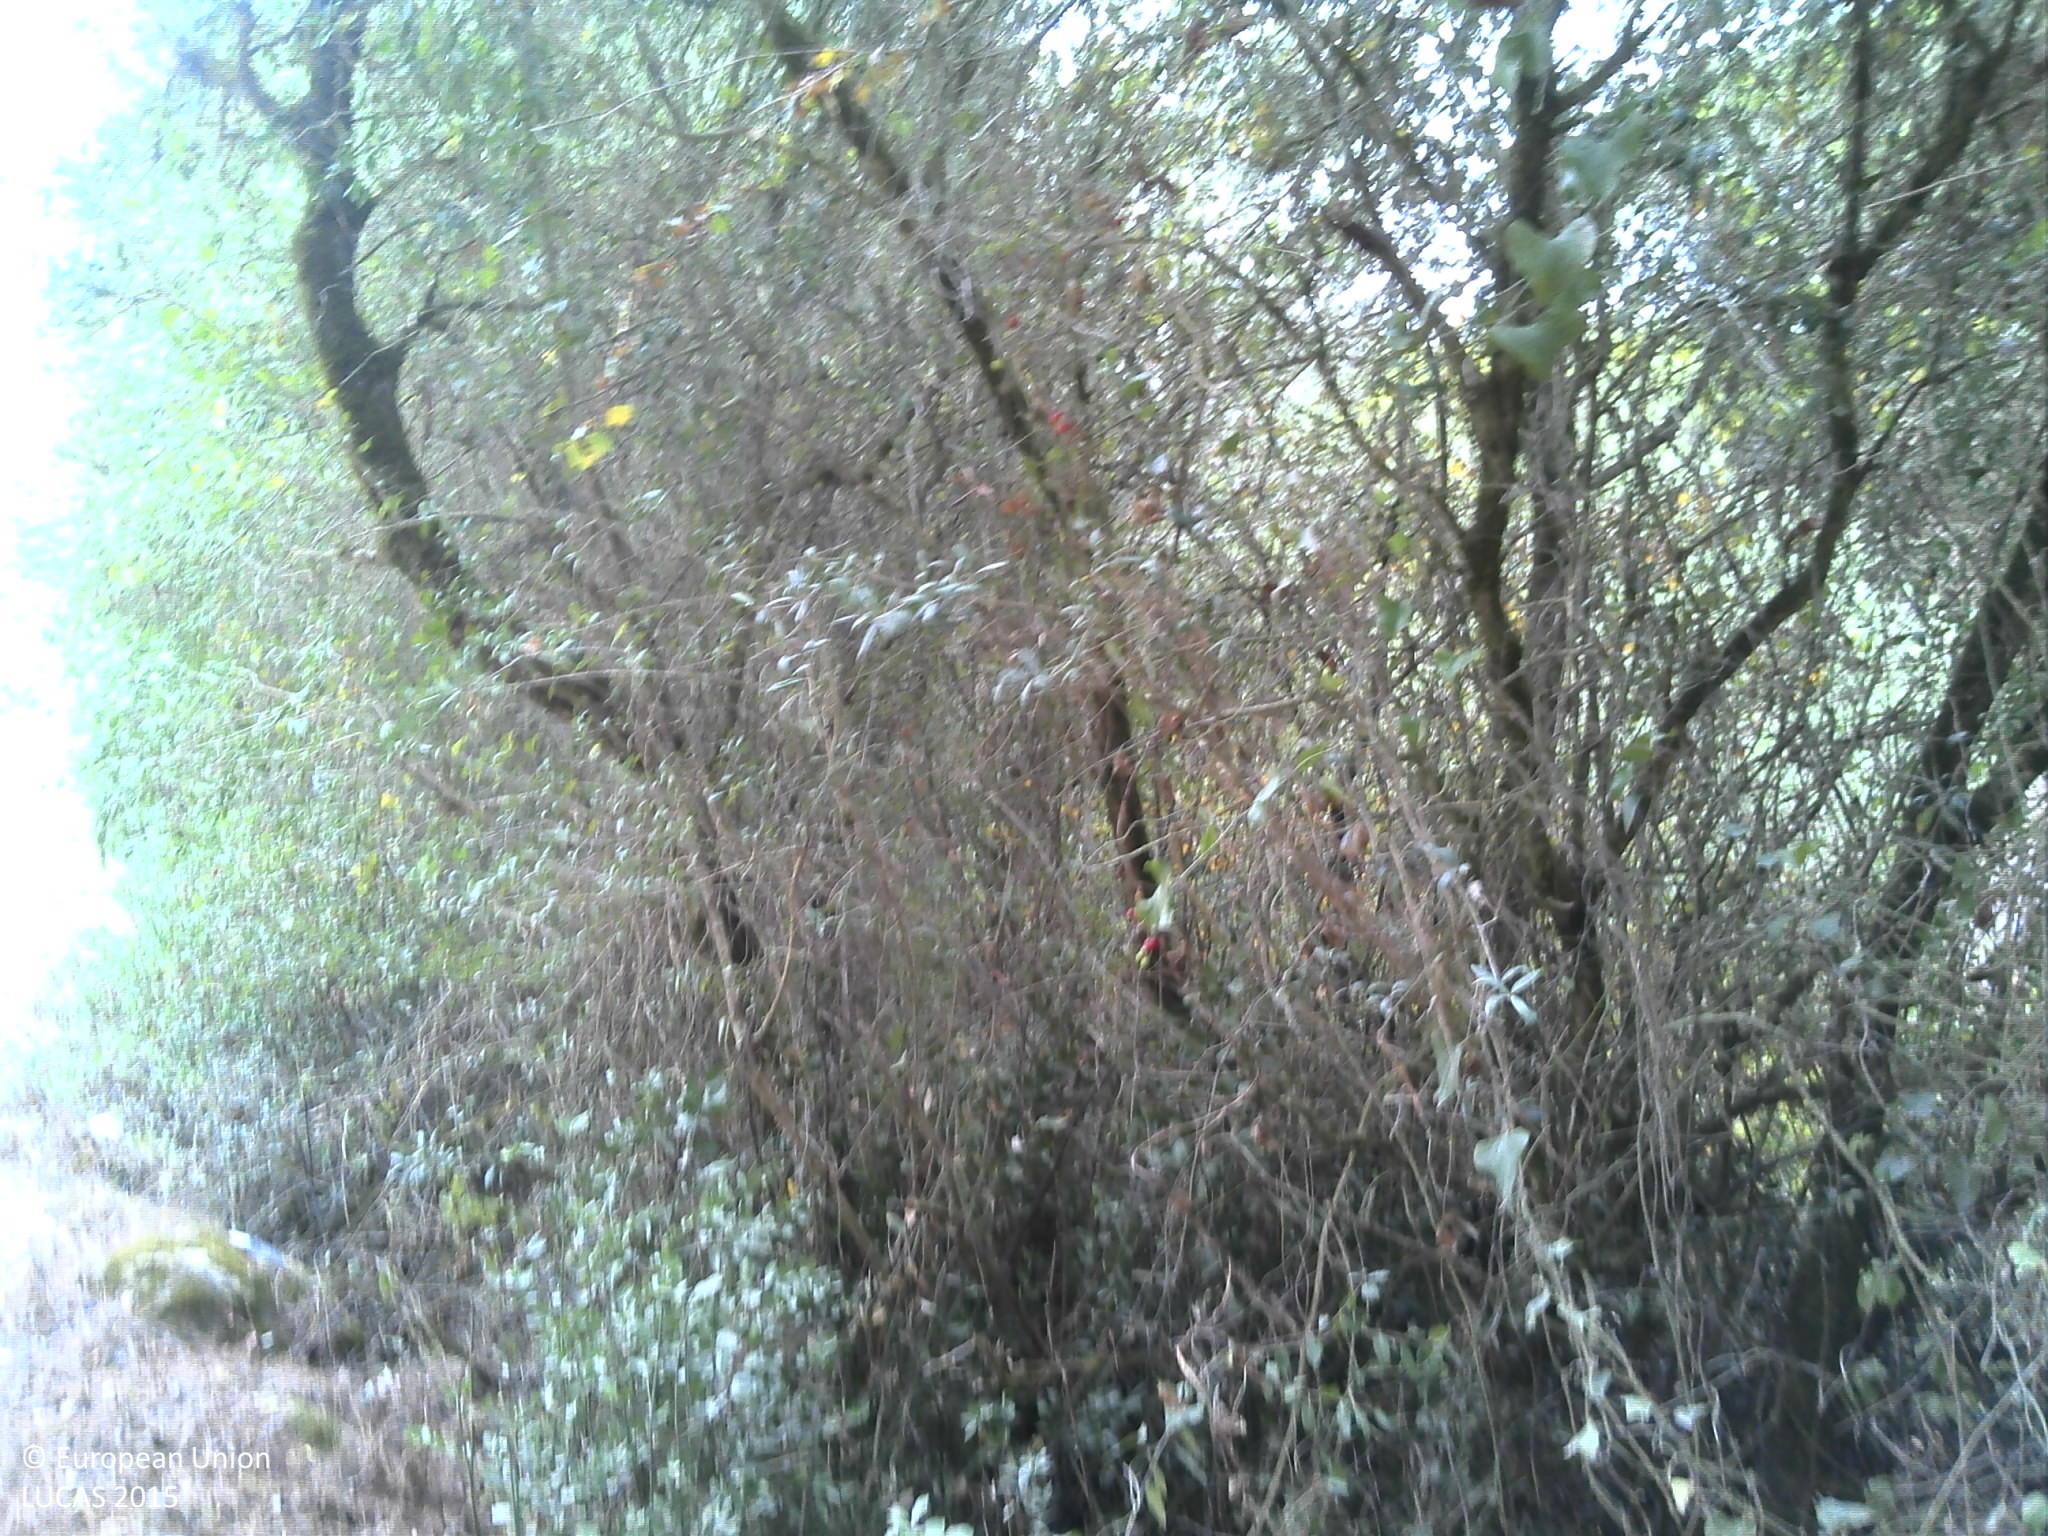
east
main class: Woodland
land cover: Broadleaved woodland
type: broadleaved evergreen forest
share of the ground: 25 - 50 %
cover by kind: broadleaved forest trees 40 %, shrubs 40 %, unconsolidated bare surface 20 %
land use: Forestry
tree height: > 5 m
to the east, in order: Broadleaved woodland; Pine dominated coniferous woodland; Dry stone walls; Pine dominated coniferous woodland; Dry stone walls; Shrubland with sparse tree cover
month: August
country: PT
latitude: 38.8285
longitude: -9.4024
